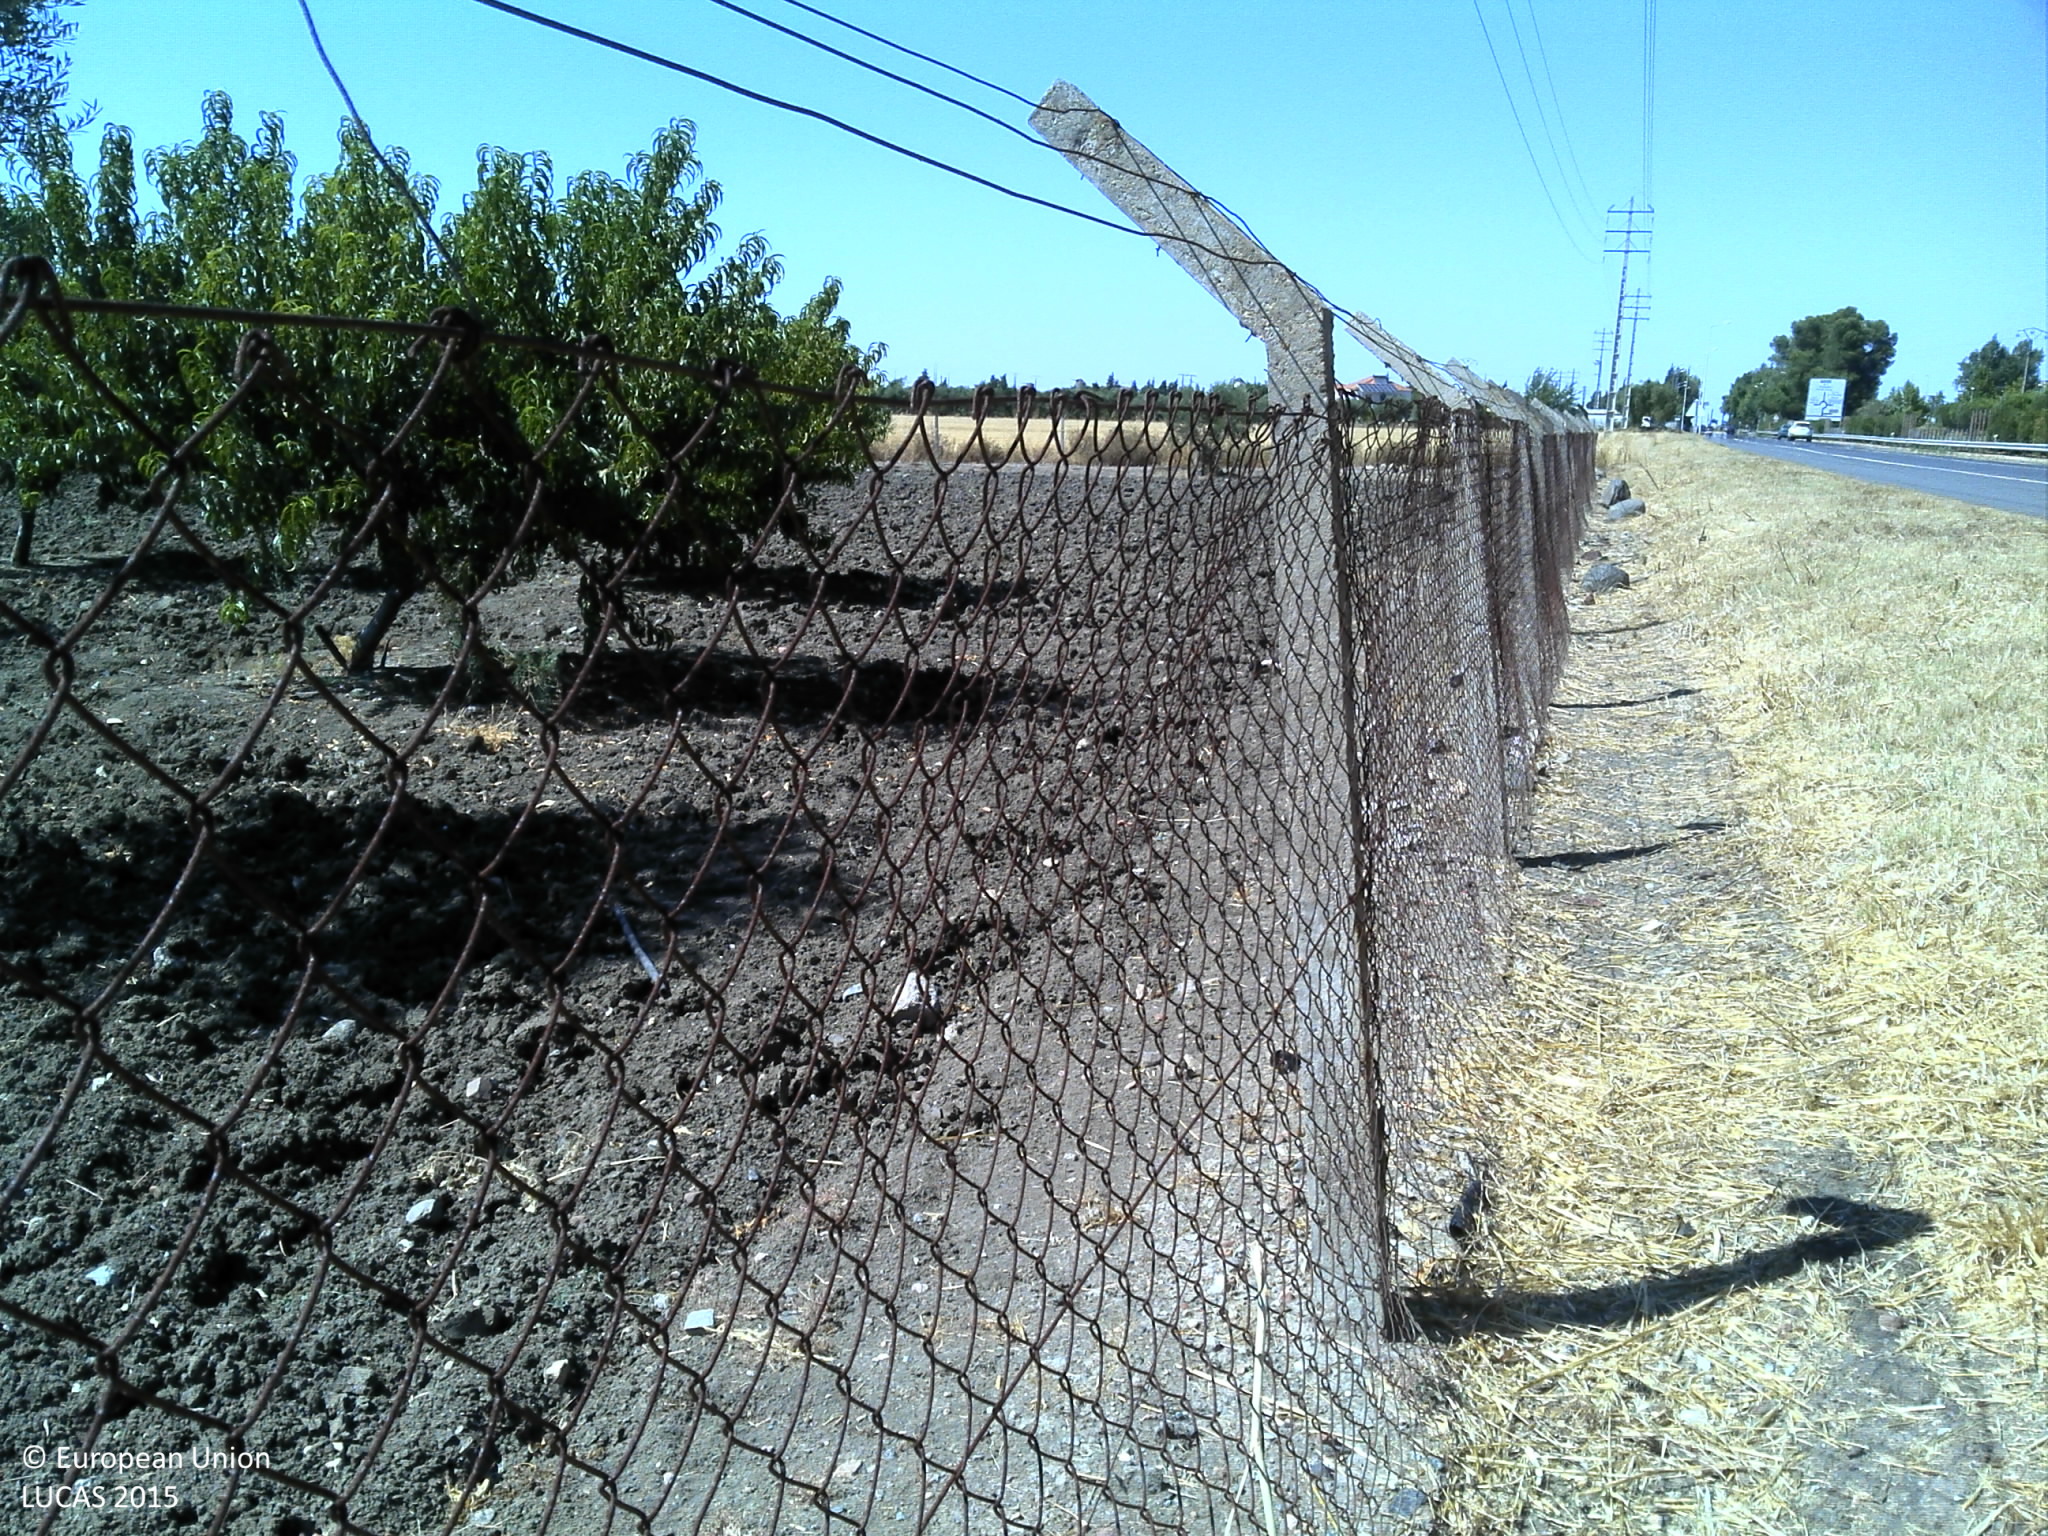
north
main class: Cropland
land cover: Other fruit trees and berries
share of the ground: 50 - 75 %
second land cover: Other bare soil
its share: > 75 %
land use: Agriculture (excluding fallow land and kitchen gardens)
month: August
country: PT
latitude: 38.0186
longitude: -7.8775
